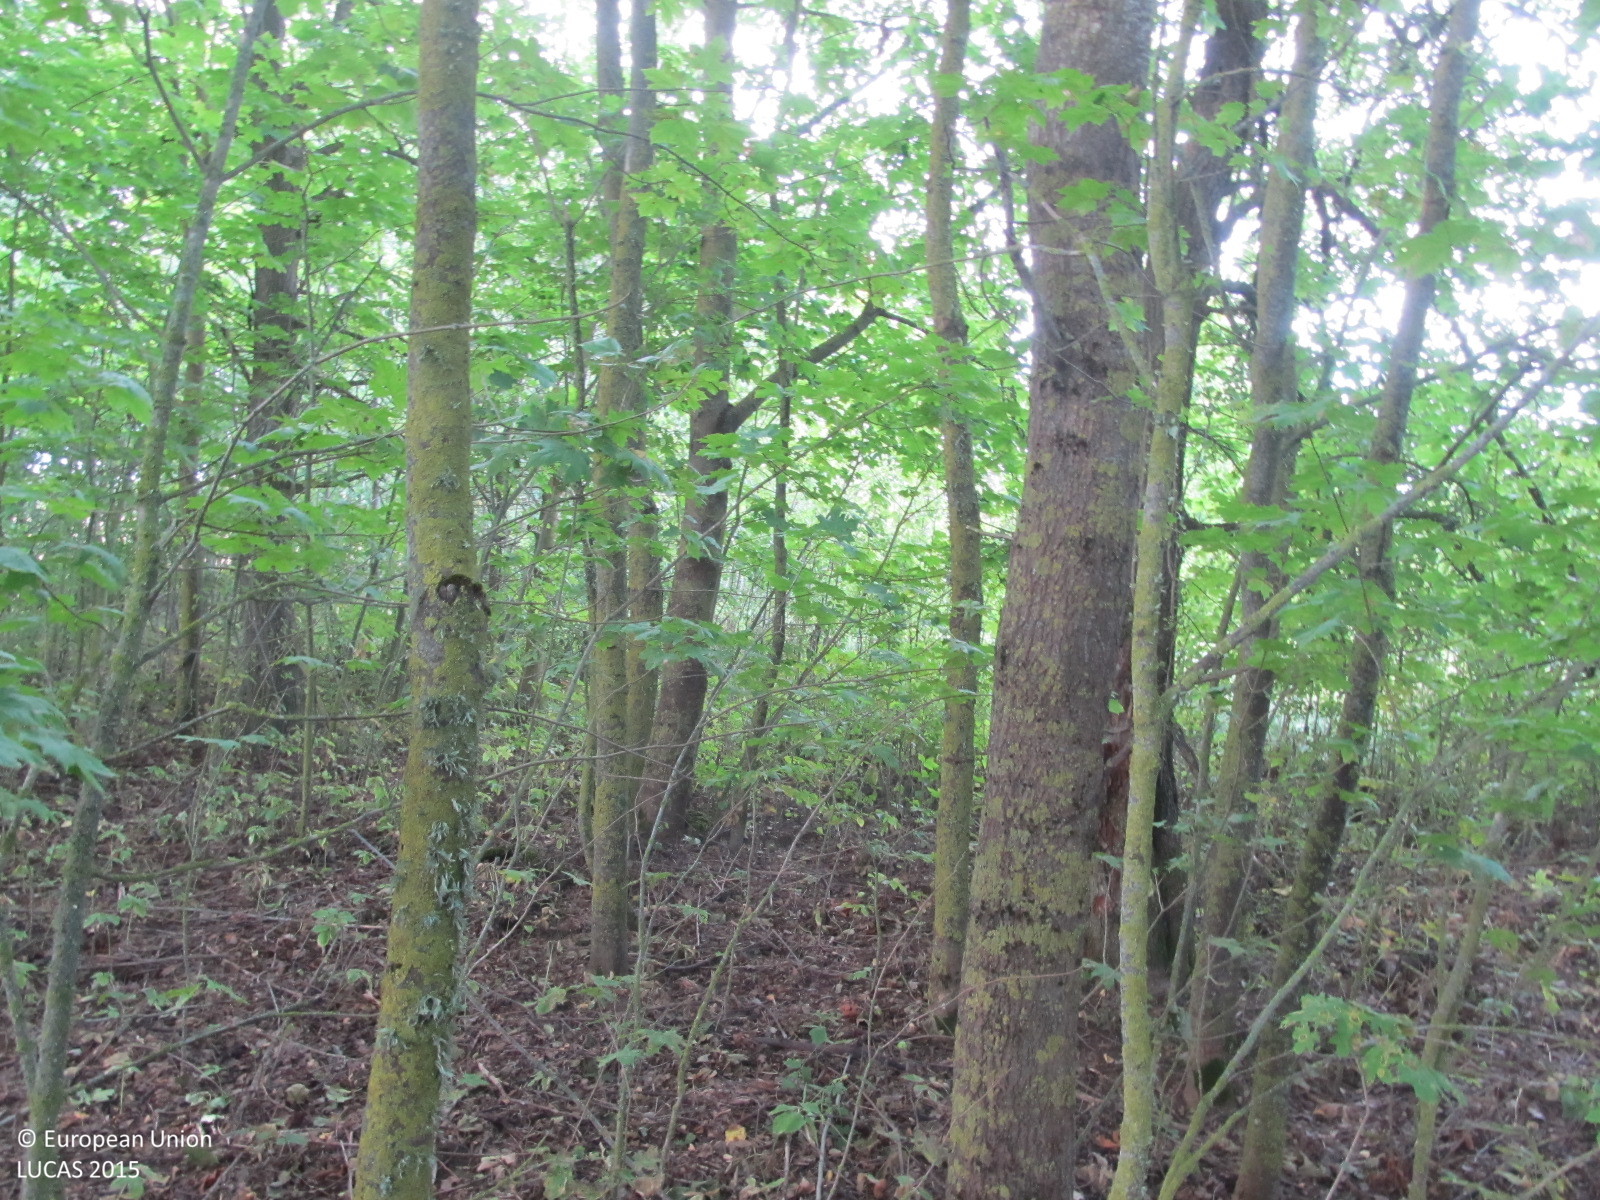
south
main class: Woodland
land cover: Broadleaved woodland
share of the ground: > 75 %
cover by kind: broadleaved forest trees 90 %, herbaceous plants 5 %, unconsolidated bare surface 5 %
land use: Forestry
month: September
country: LT
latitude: 56.3324
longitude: 23.2859
